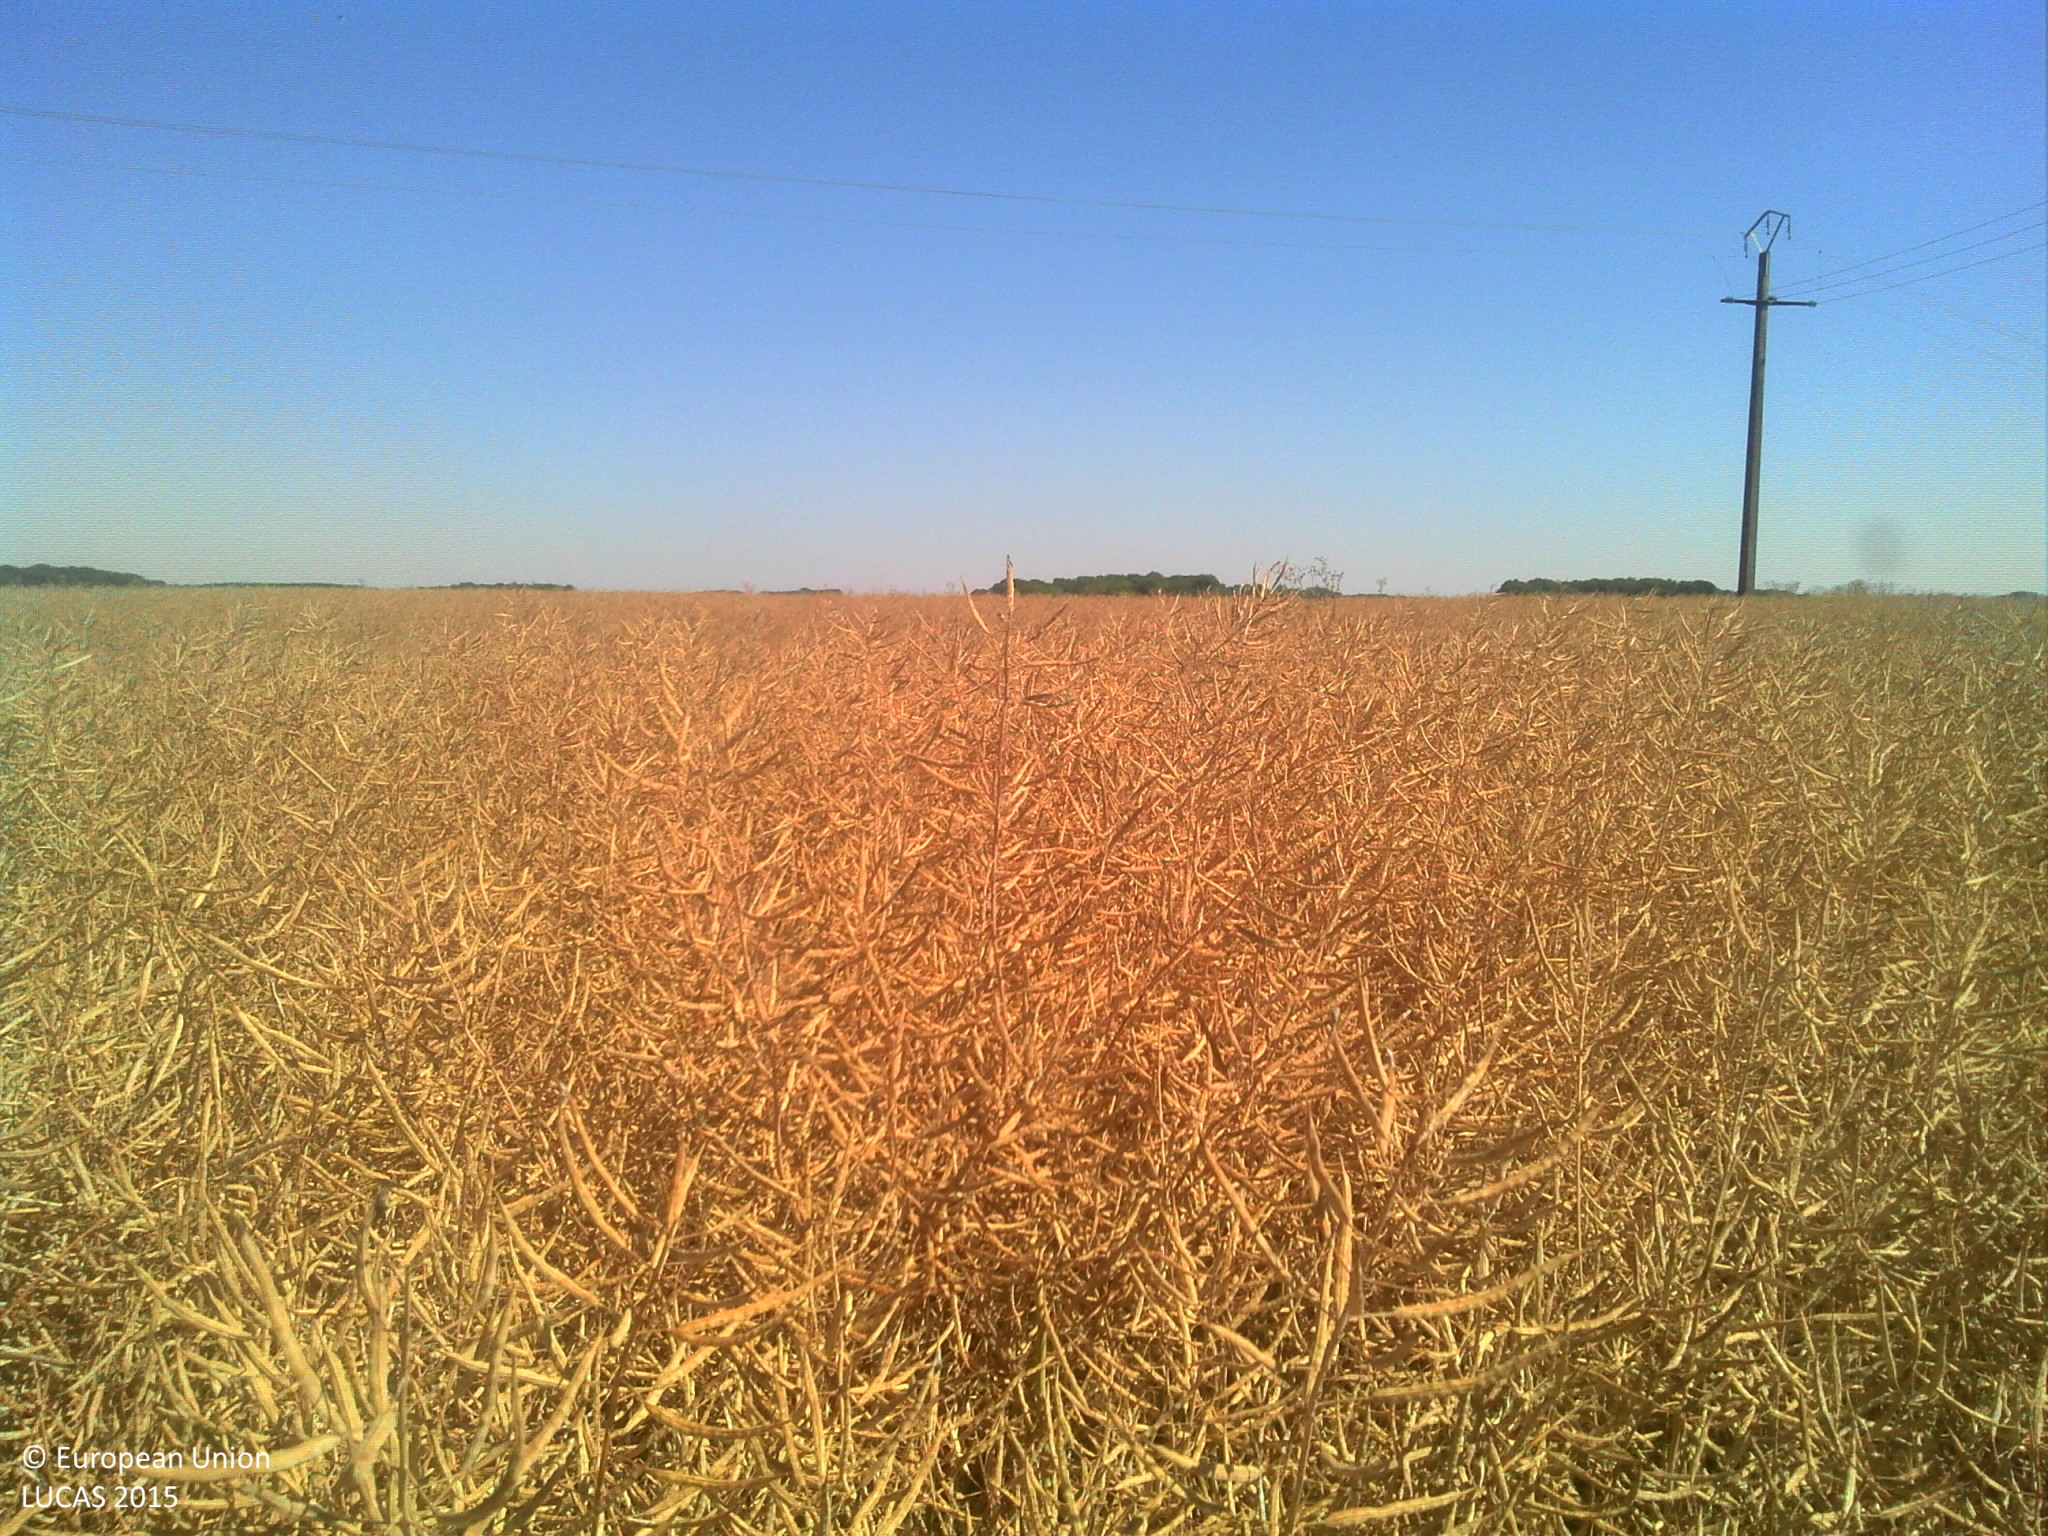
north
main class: Cropland
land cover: Rape and turnip rape
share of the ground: > 75 %
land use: Agriculture (excluding fallow land and kitchen gardens)
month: July
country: FR
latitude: 48.0087
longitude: 1.3372
